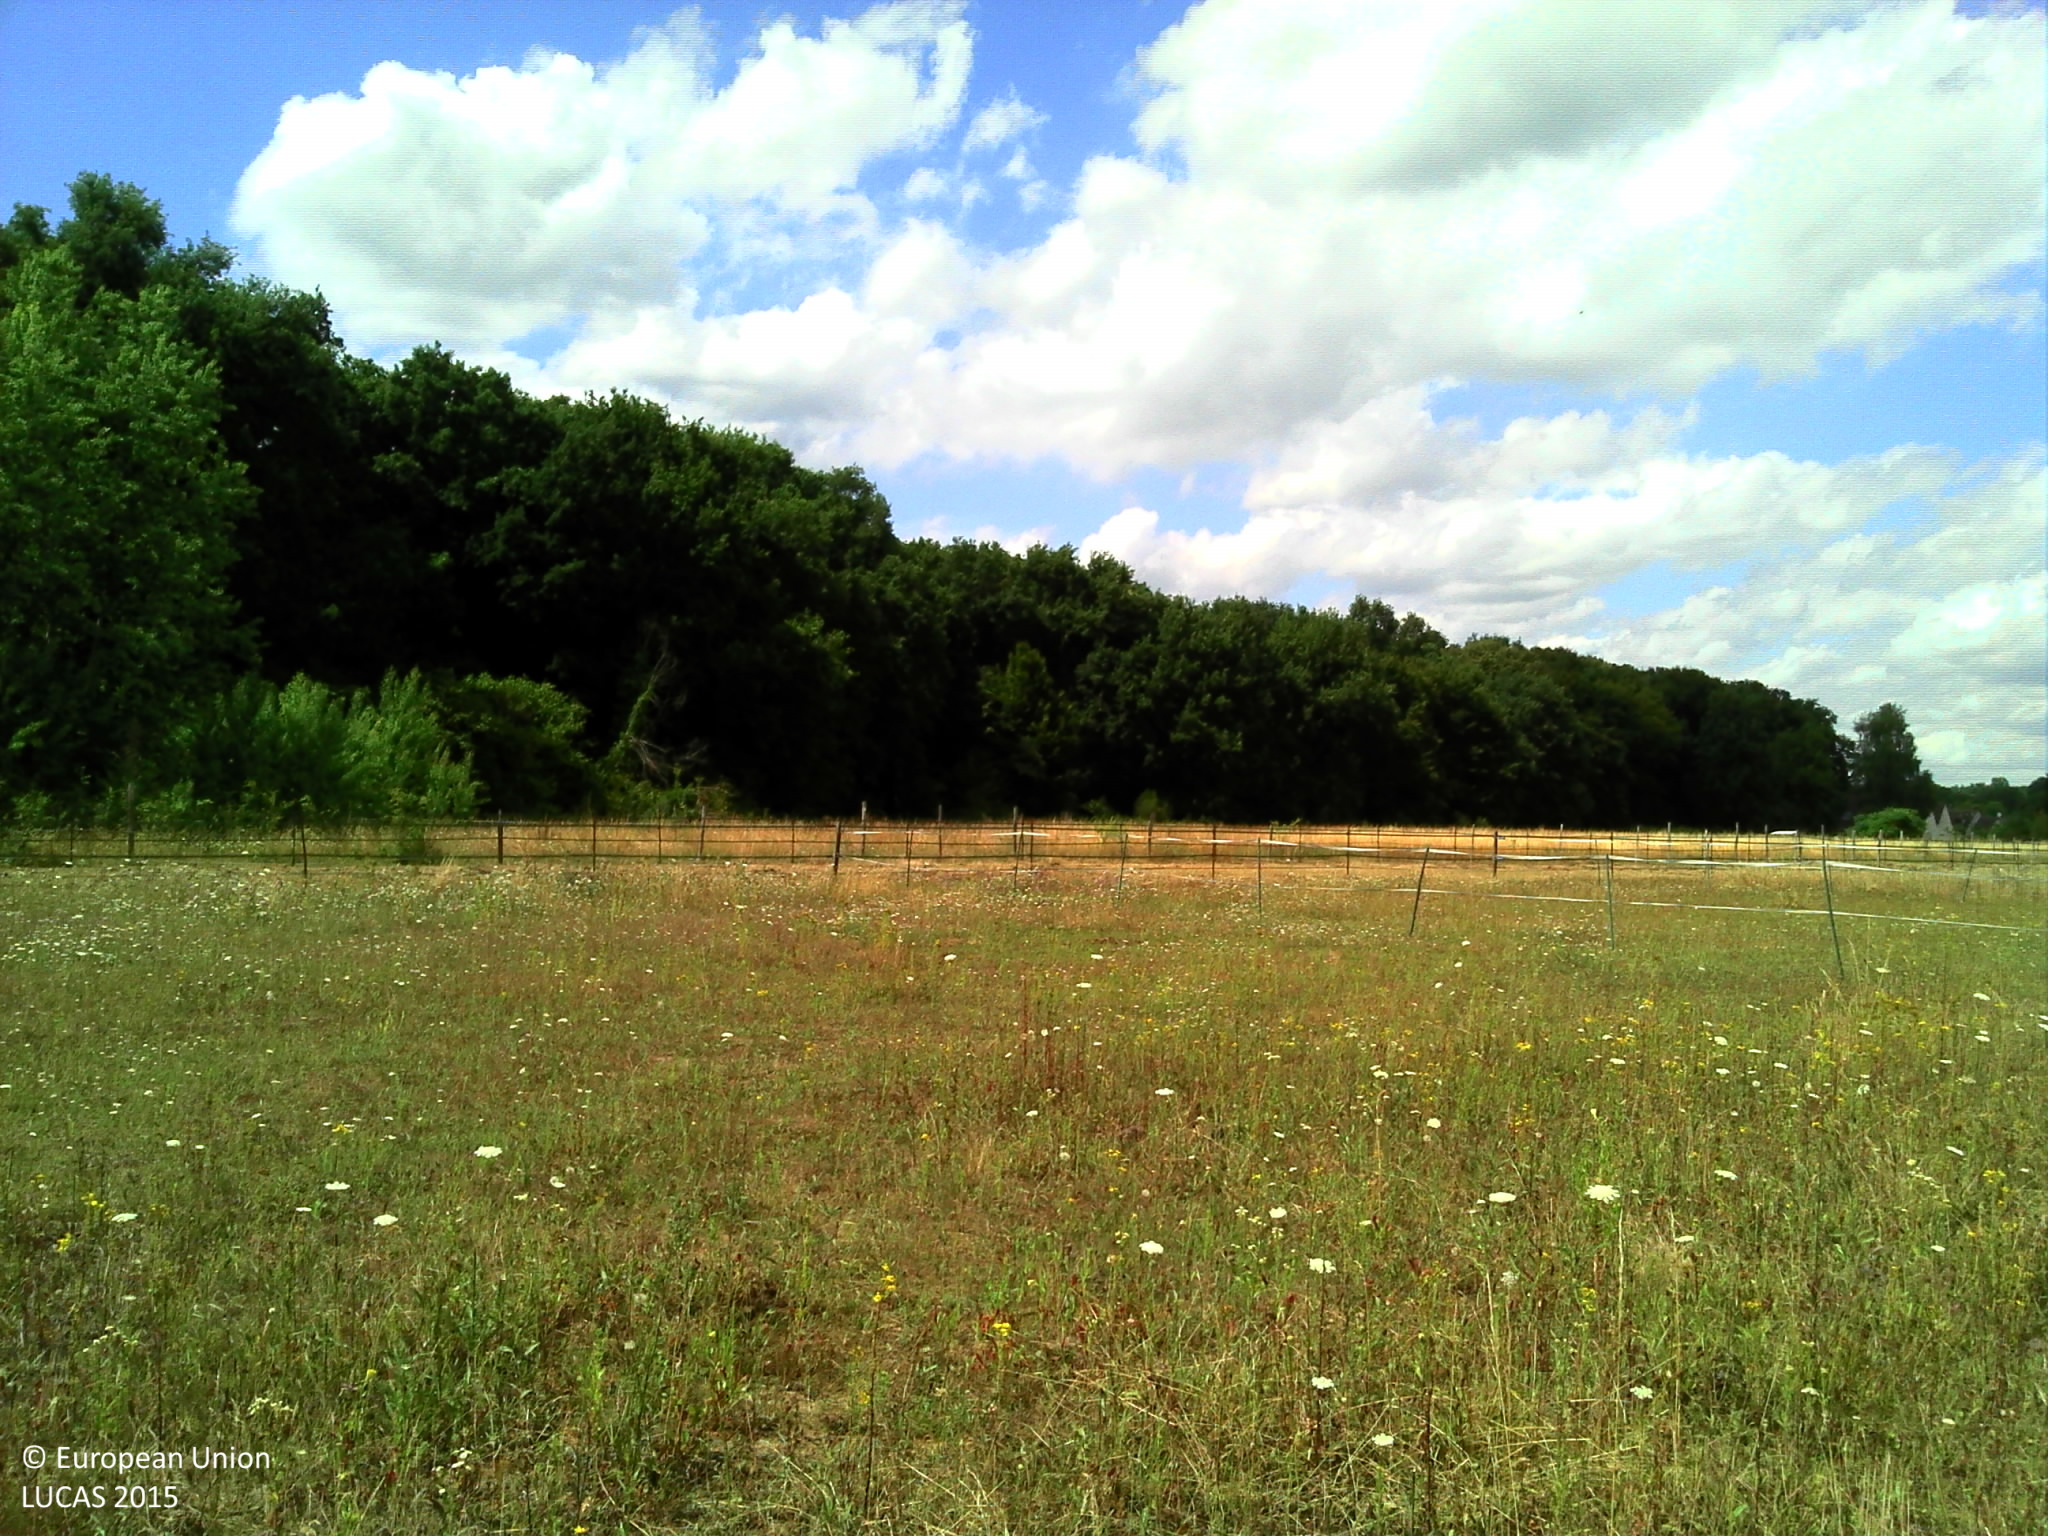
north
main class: Grassland
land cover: Grassland without tree/shrub cover
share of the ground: > 75 %
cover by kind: herbaceous plants 100 %
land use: Agriculture (excluding fallow land and kitchen gardens)
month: July
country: FR
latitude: 49.1471
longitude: 2.5720
